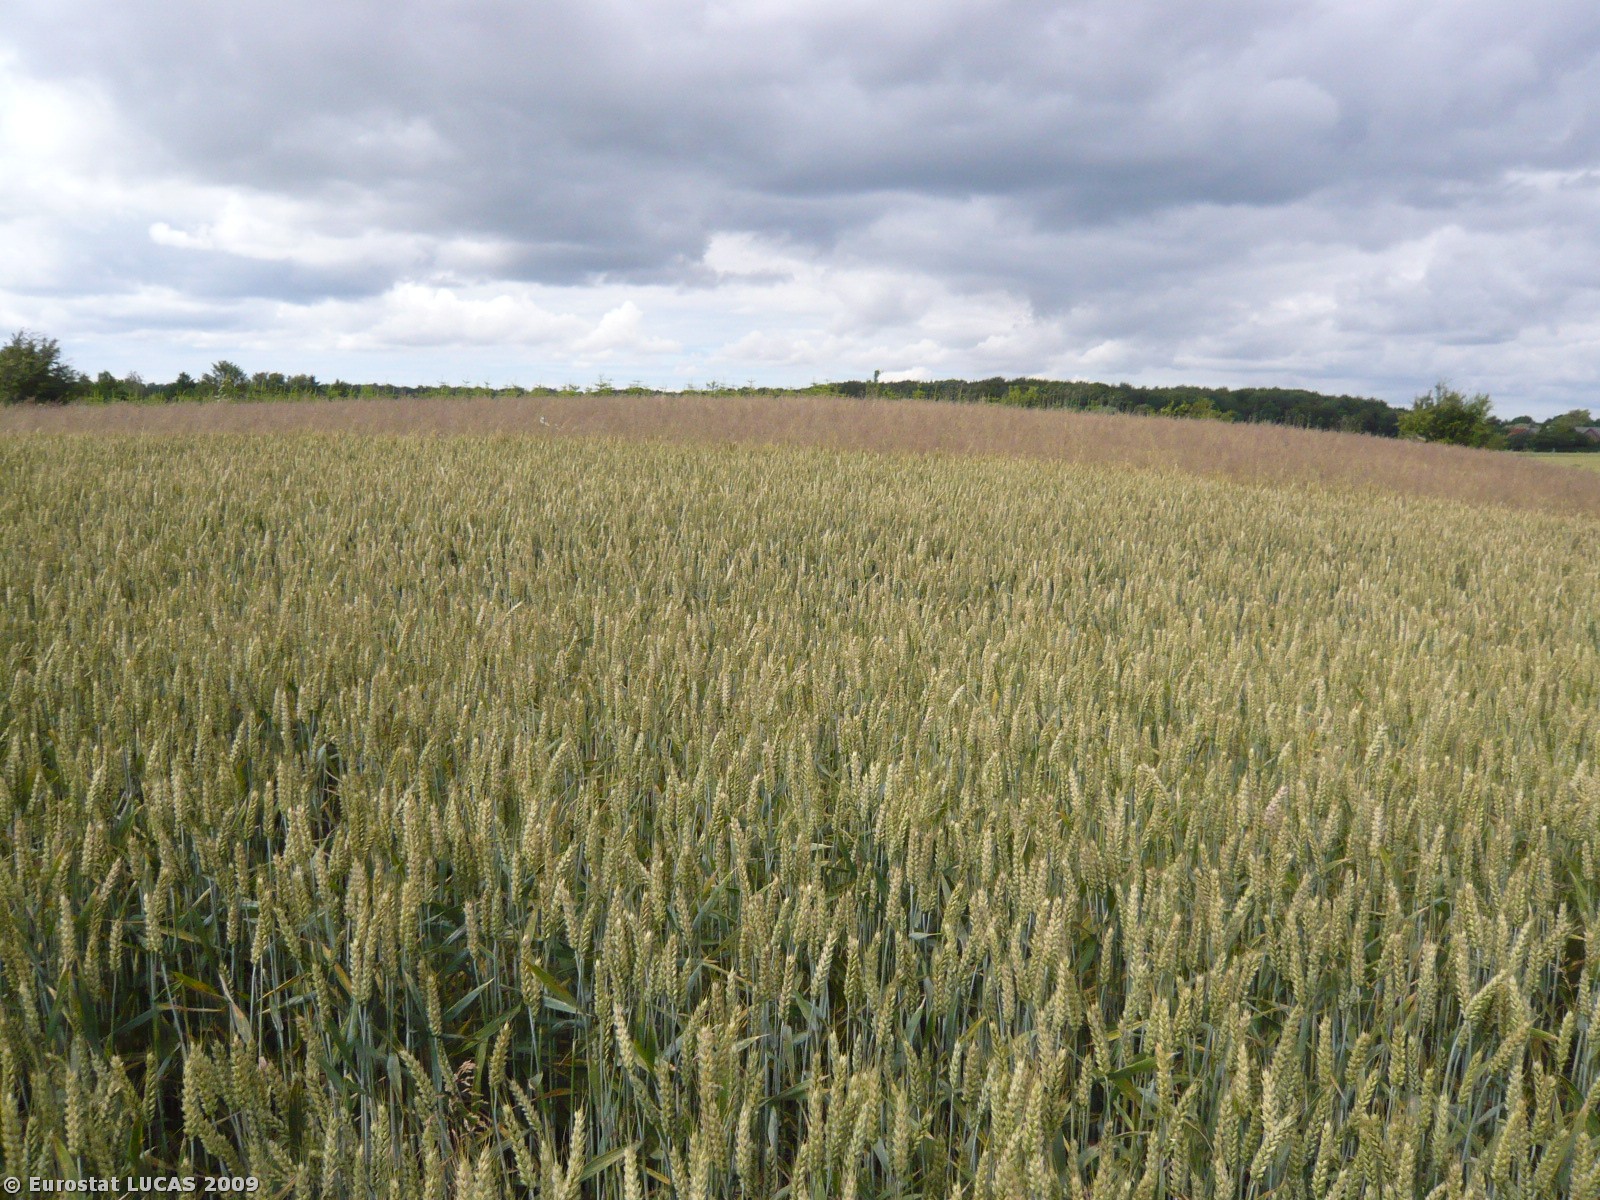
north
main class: Cropland
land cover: Common wheat
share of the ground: > 75 %
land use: Agriculture (excluding fallow land and kitchen gardens)
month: July
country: DK
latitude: 55.5321
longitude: 11.4721
